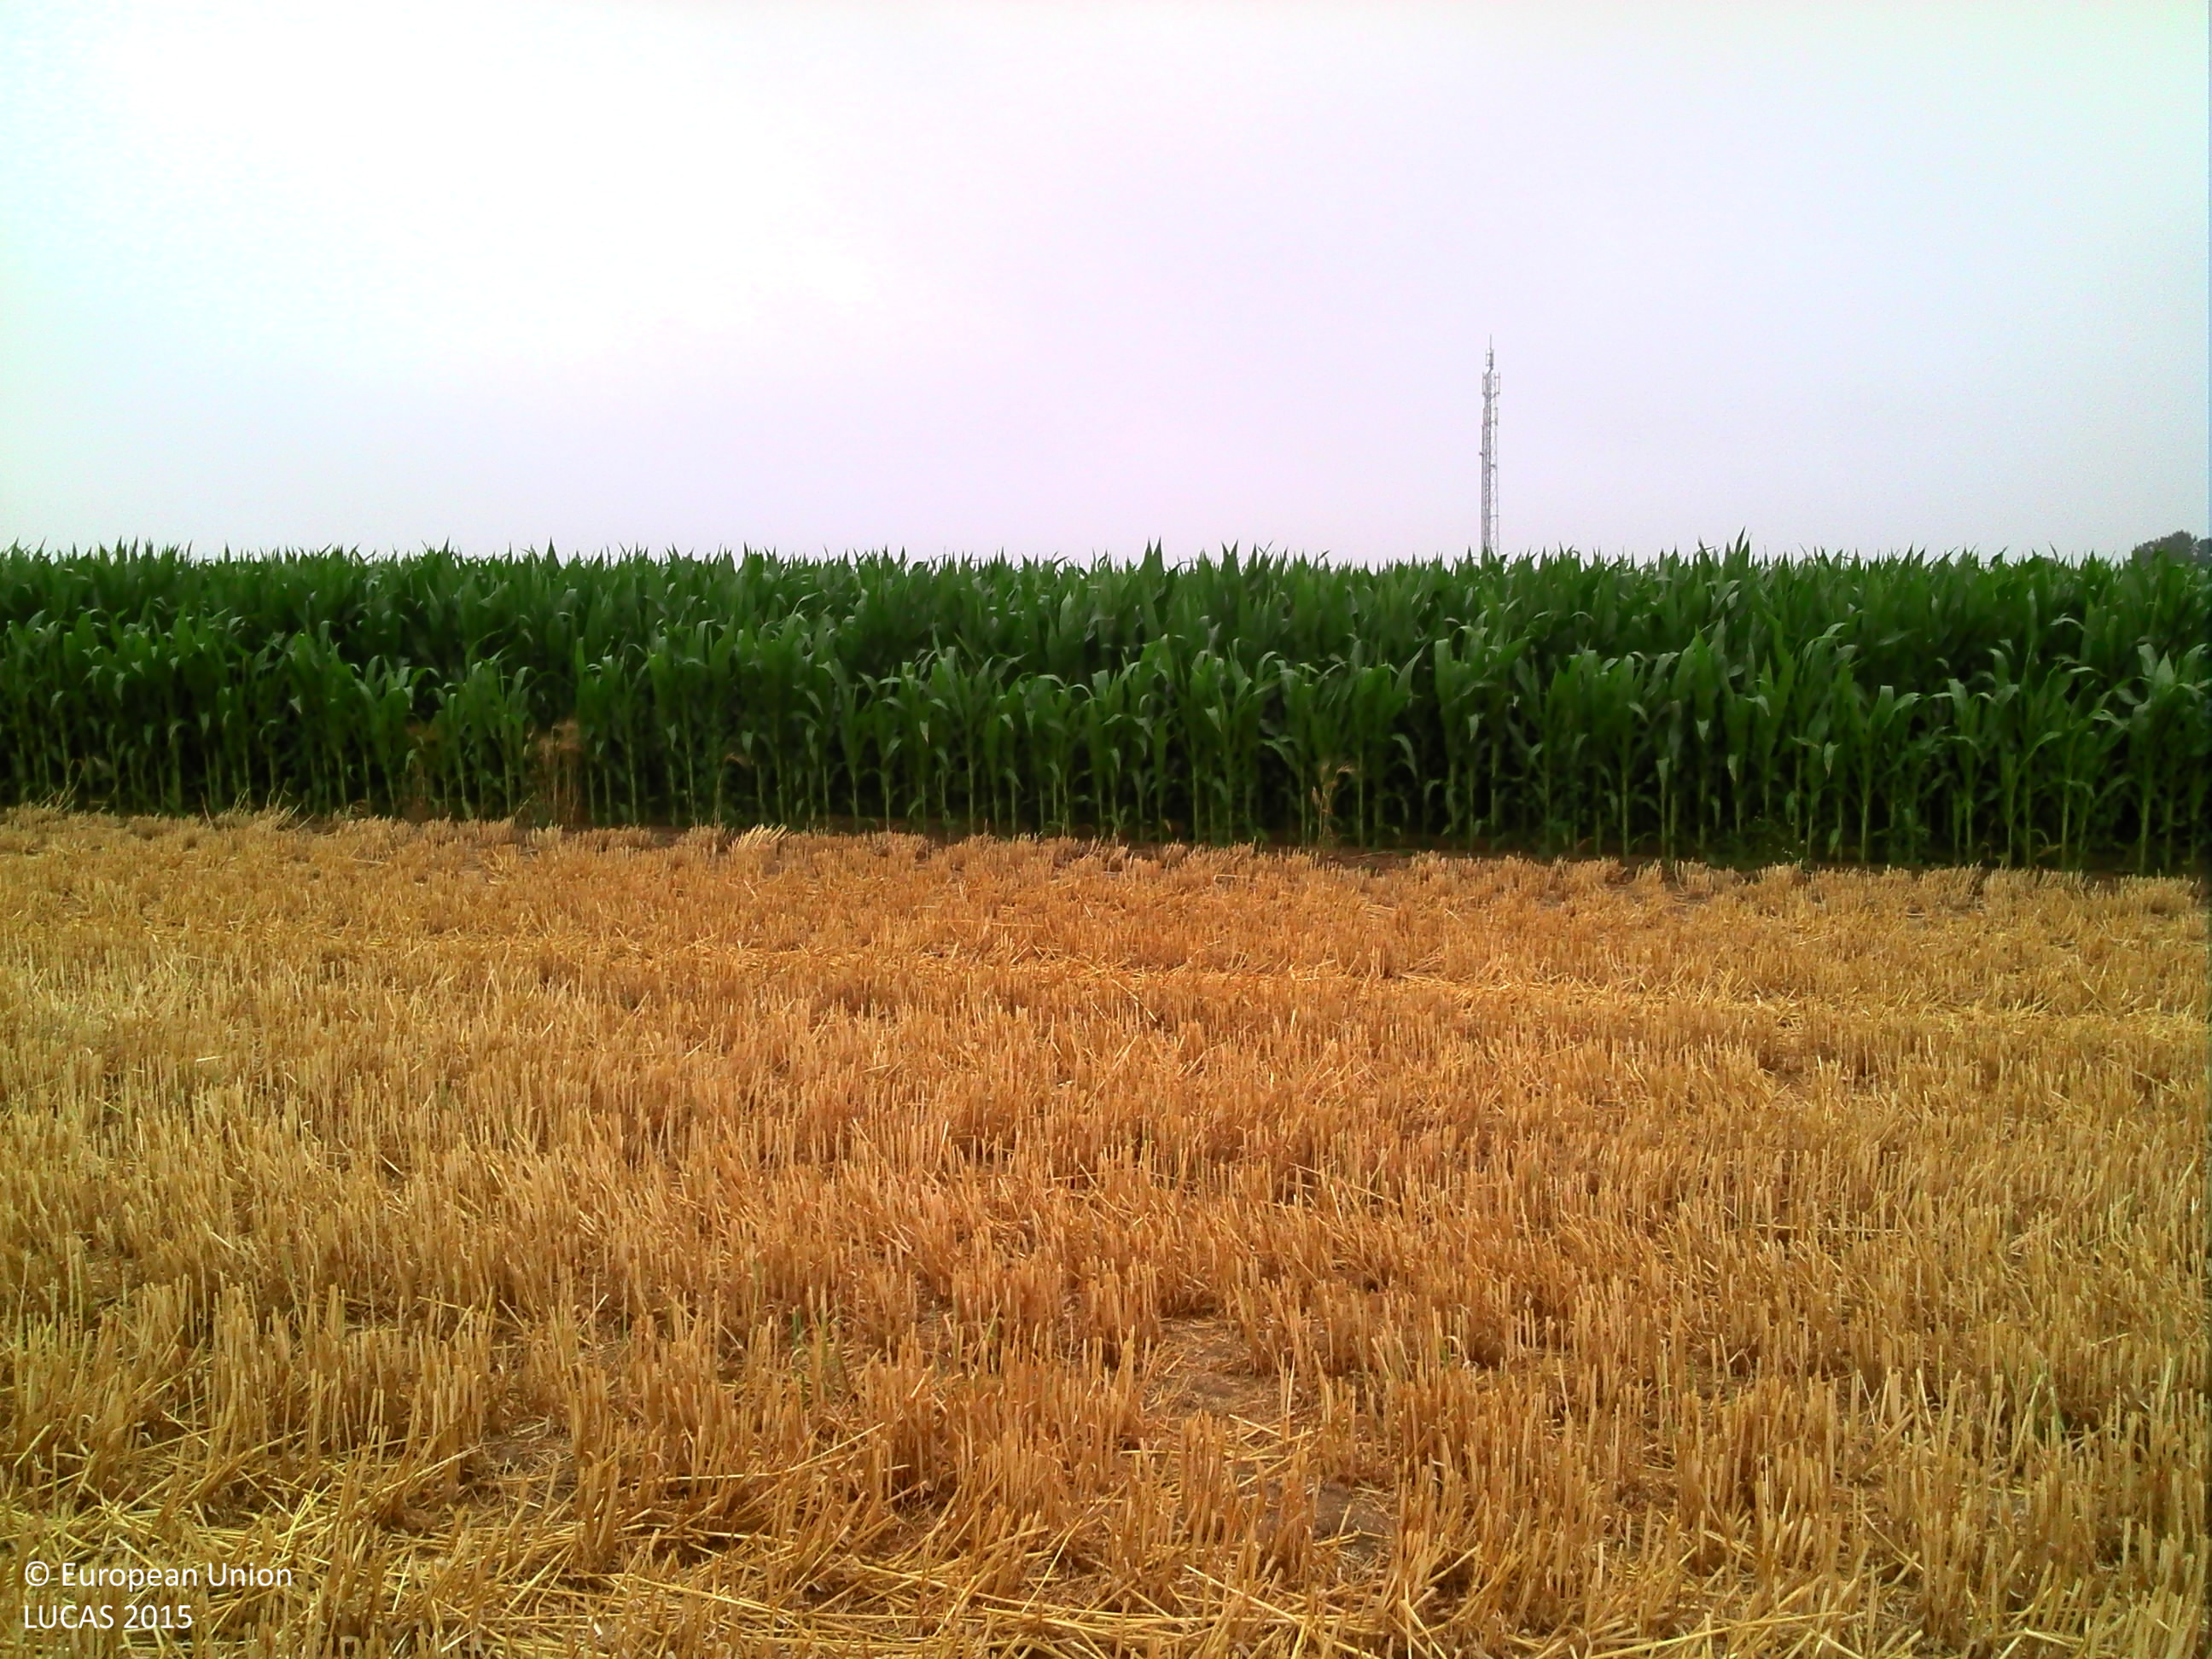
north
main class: Cropland
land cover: Barley
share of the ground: > 75 %
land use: Agriculture (excluding fallow land and kitchen gardens)
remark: Harvested field
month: July
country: BE
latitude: 50.7641
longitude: 5.5606
